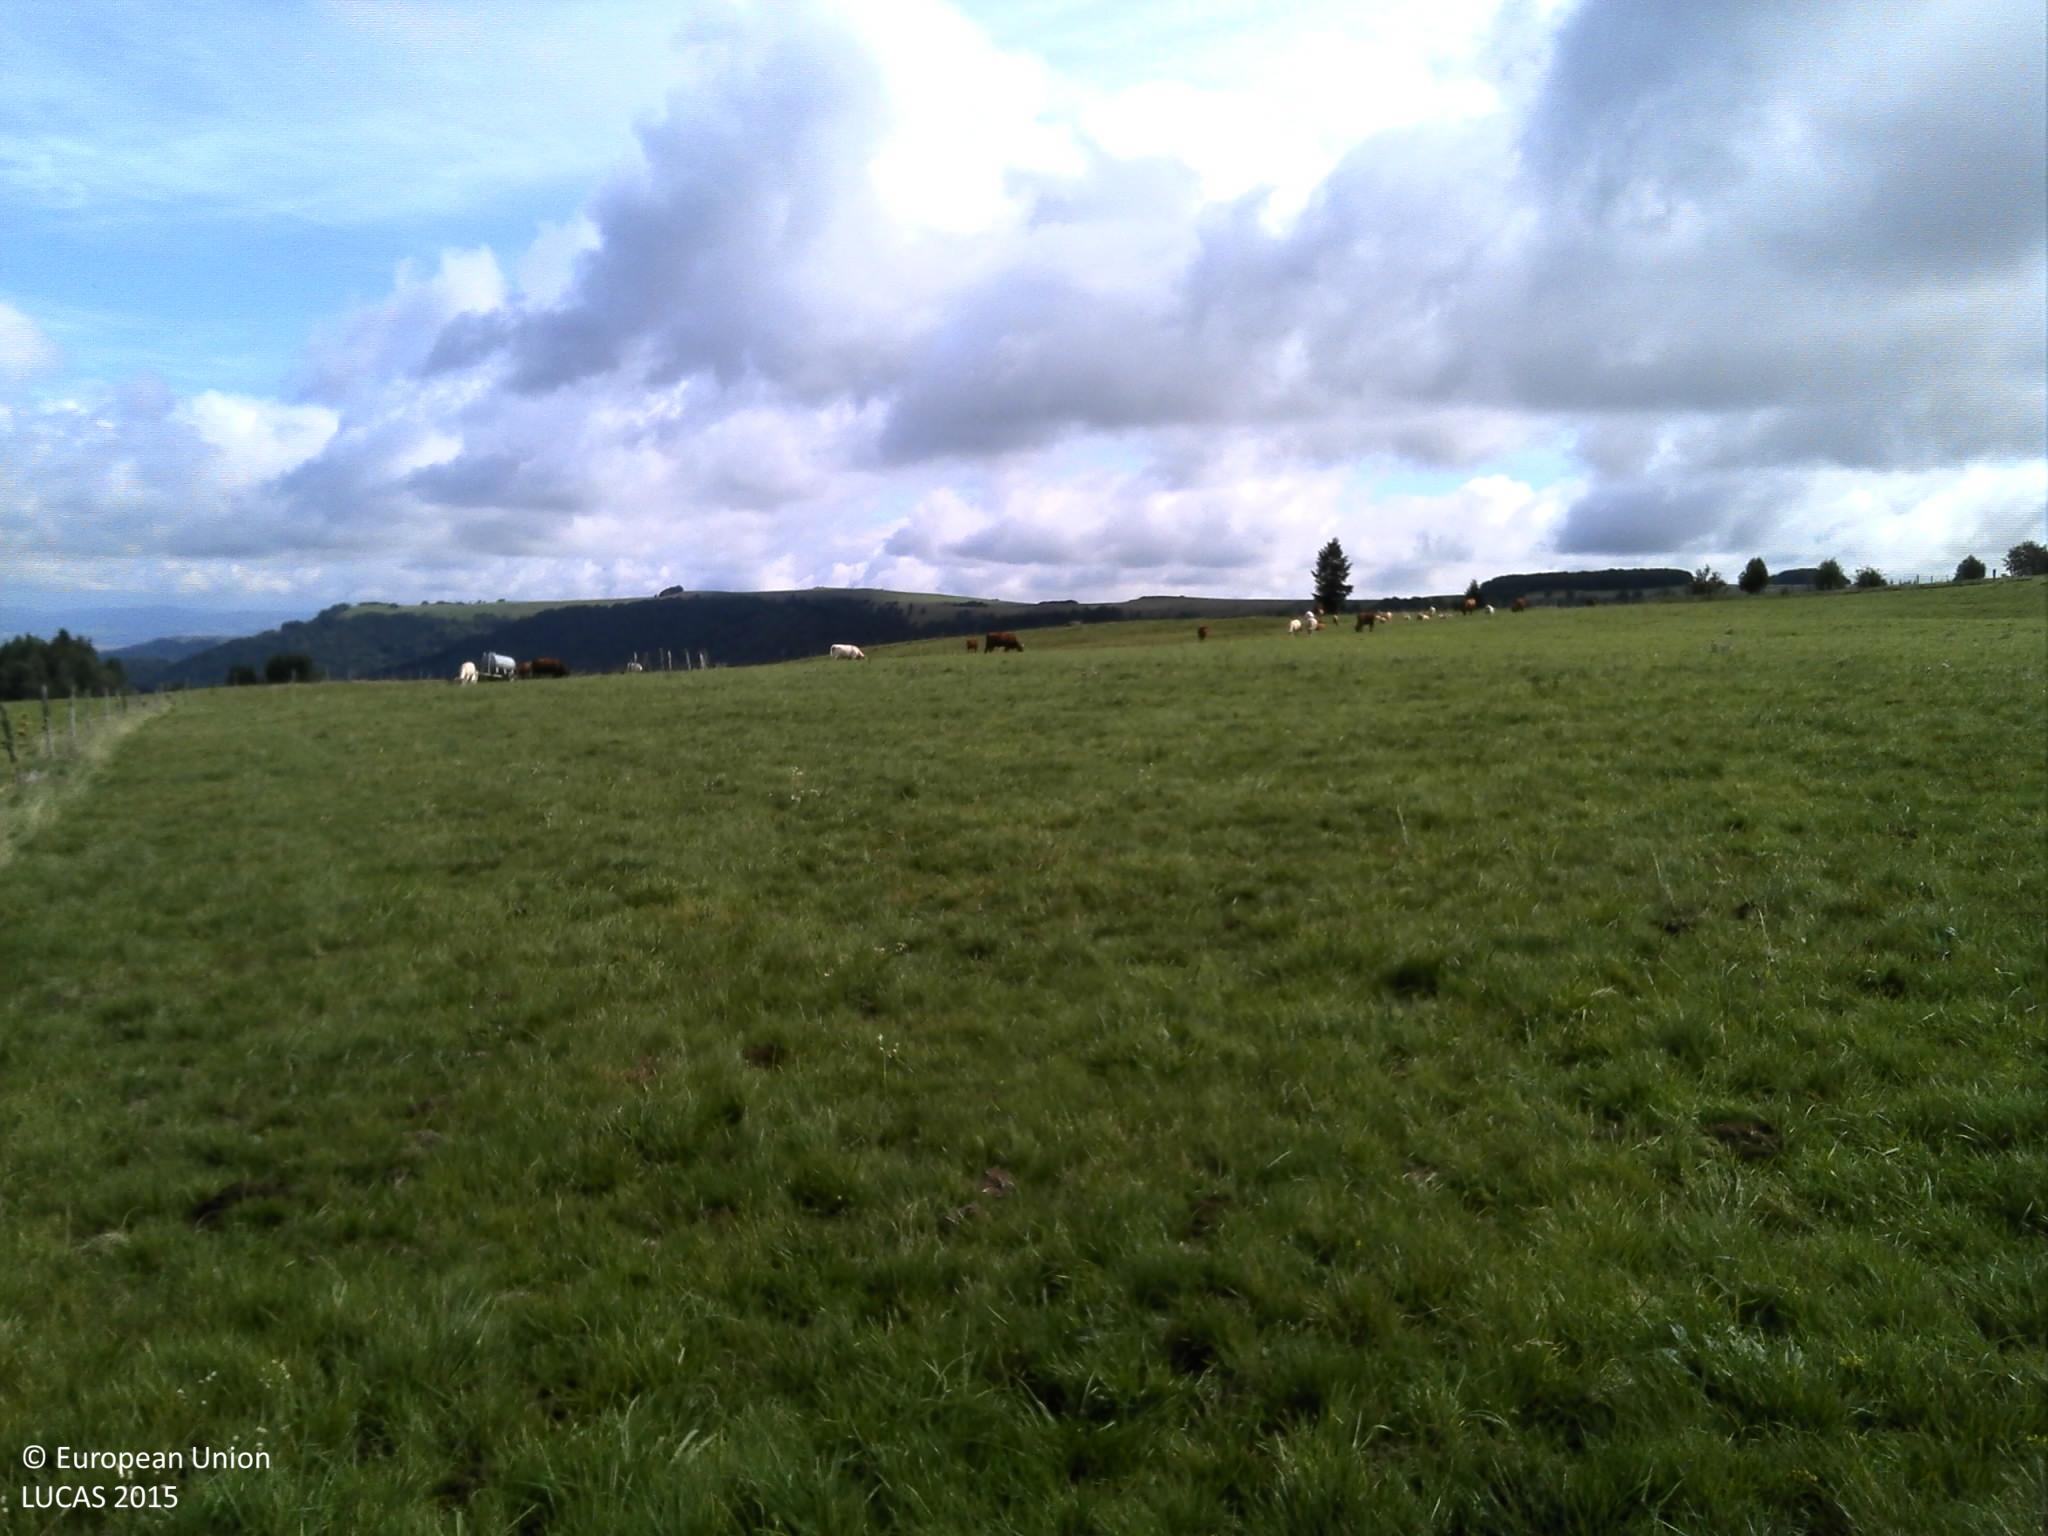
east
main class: Grassland
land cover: Grassland without tree/shrub cover
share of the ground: > 75 %
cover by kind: herbaceous plants 100 %
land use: Agriculture (excluding fallow land and kitchen gardens)
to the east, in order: Grassland without tree/shrub cover; Fences; Grassland without tree/shrub cover; Fences; Grassland without tree/shrub cover
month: September
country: FR
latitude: 45.5019
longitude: 2.9227
